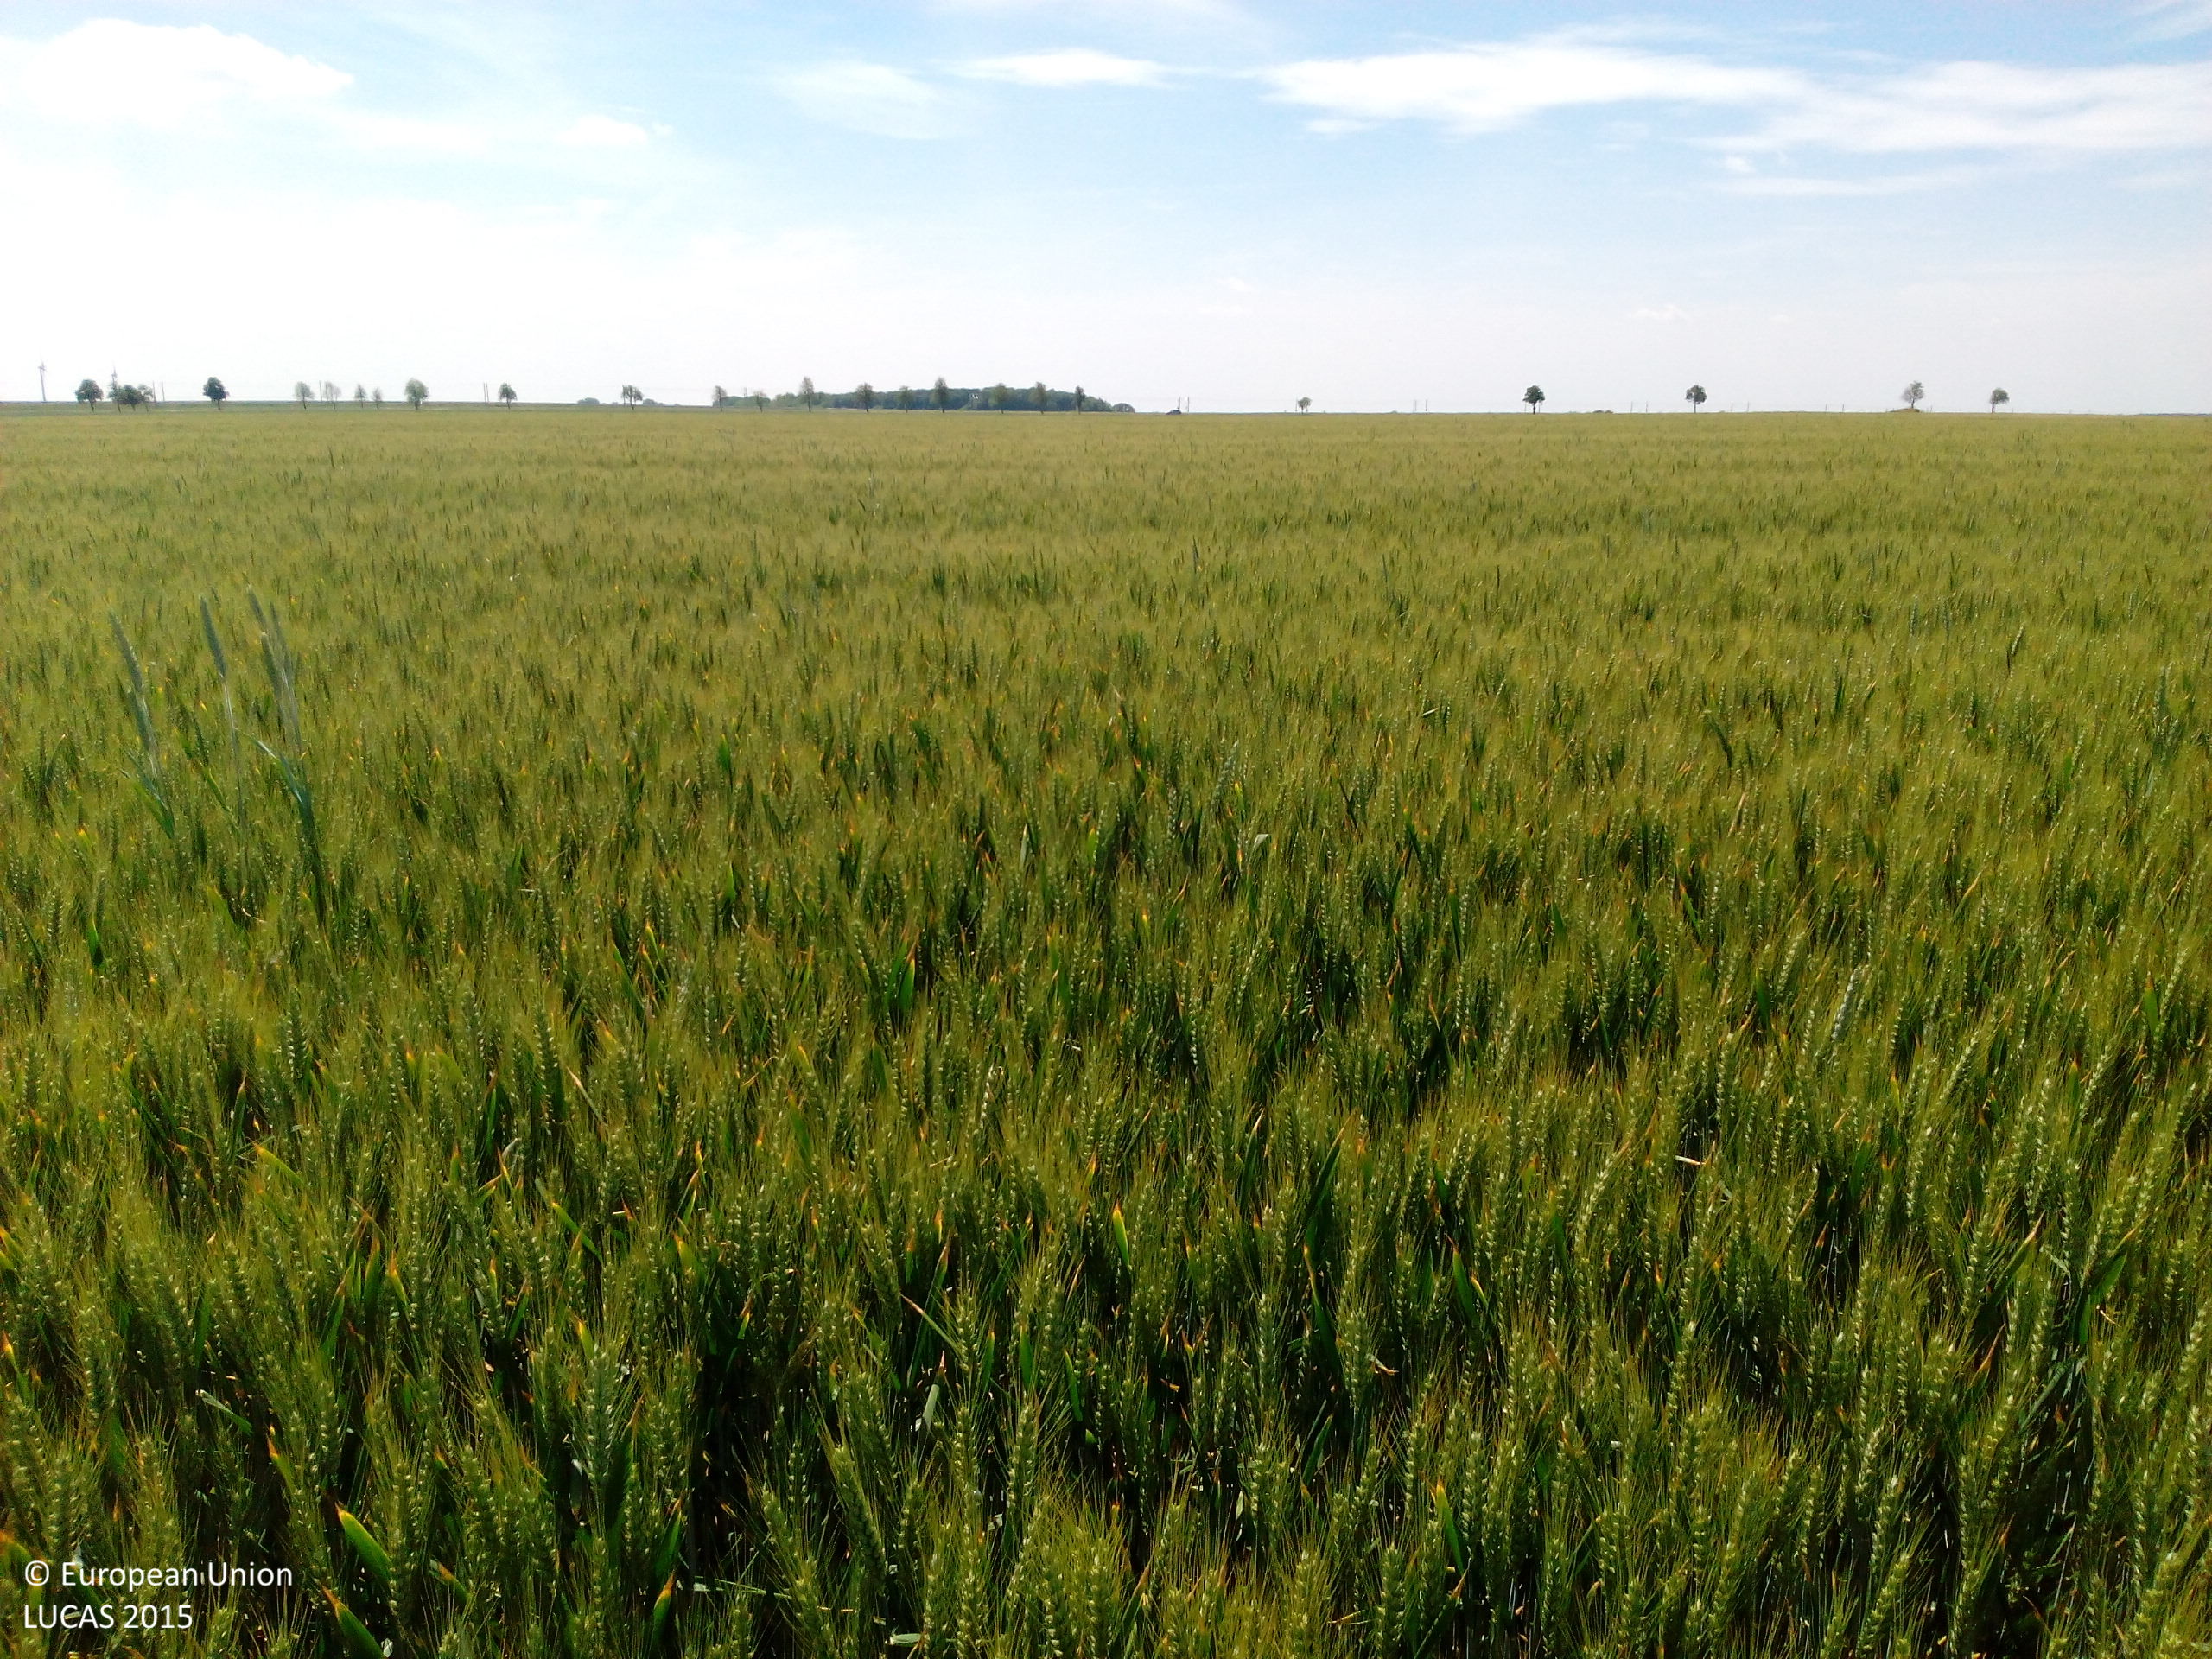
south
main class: Cropland
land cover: Rye
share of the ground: > 75 %
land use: Agriculture (excluding fallow land and kitchen gardens)
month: June
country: DE
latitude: 51.4421
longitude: 12.0858
